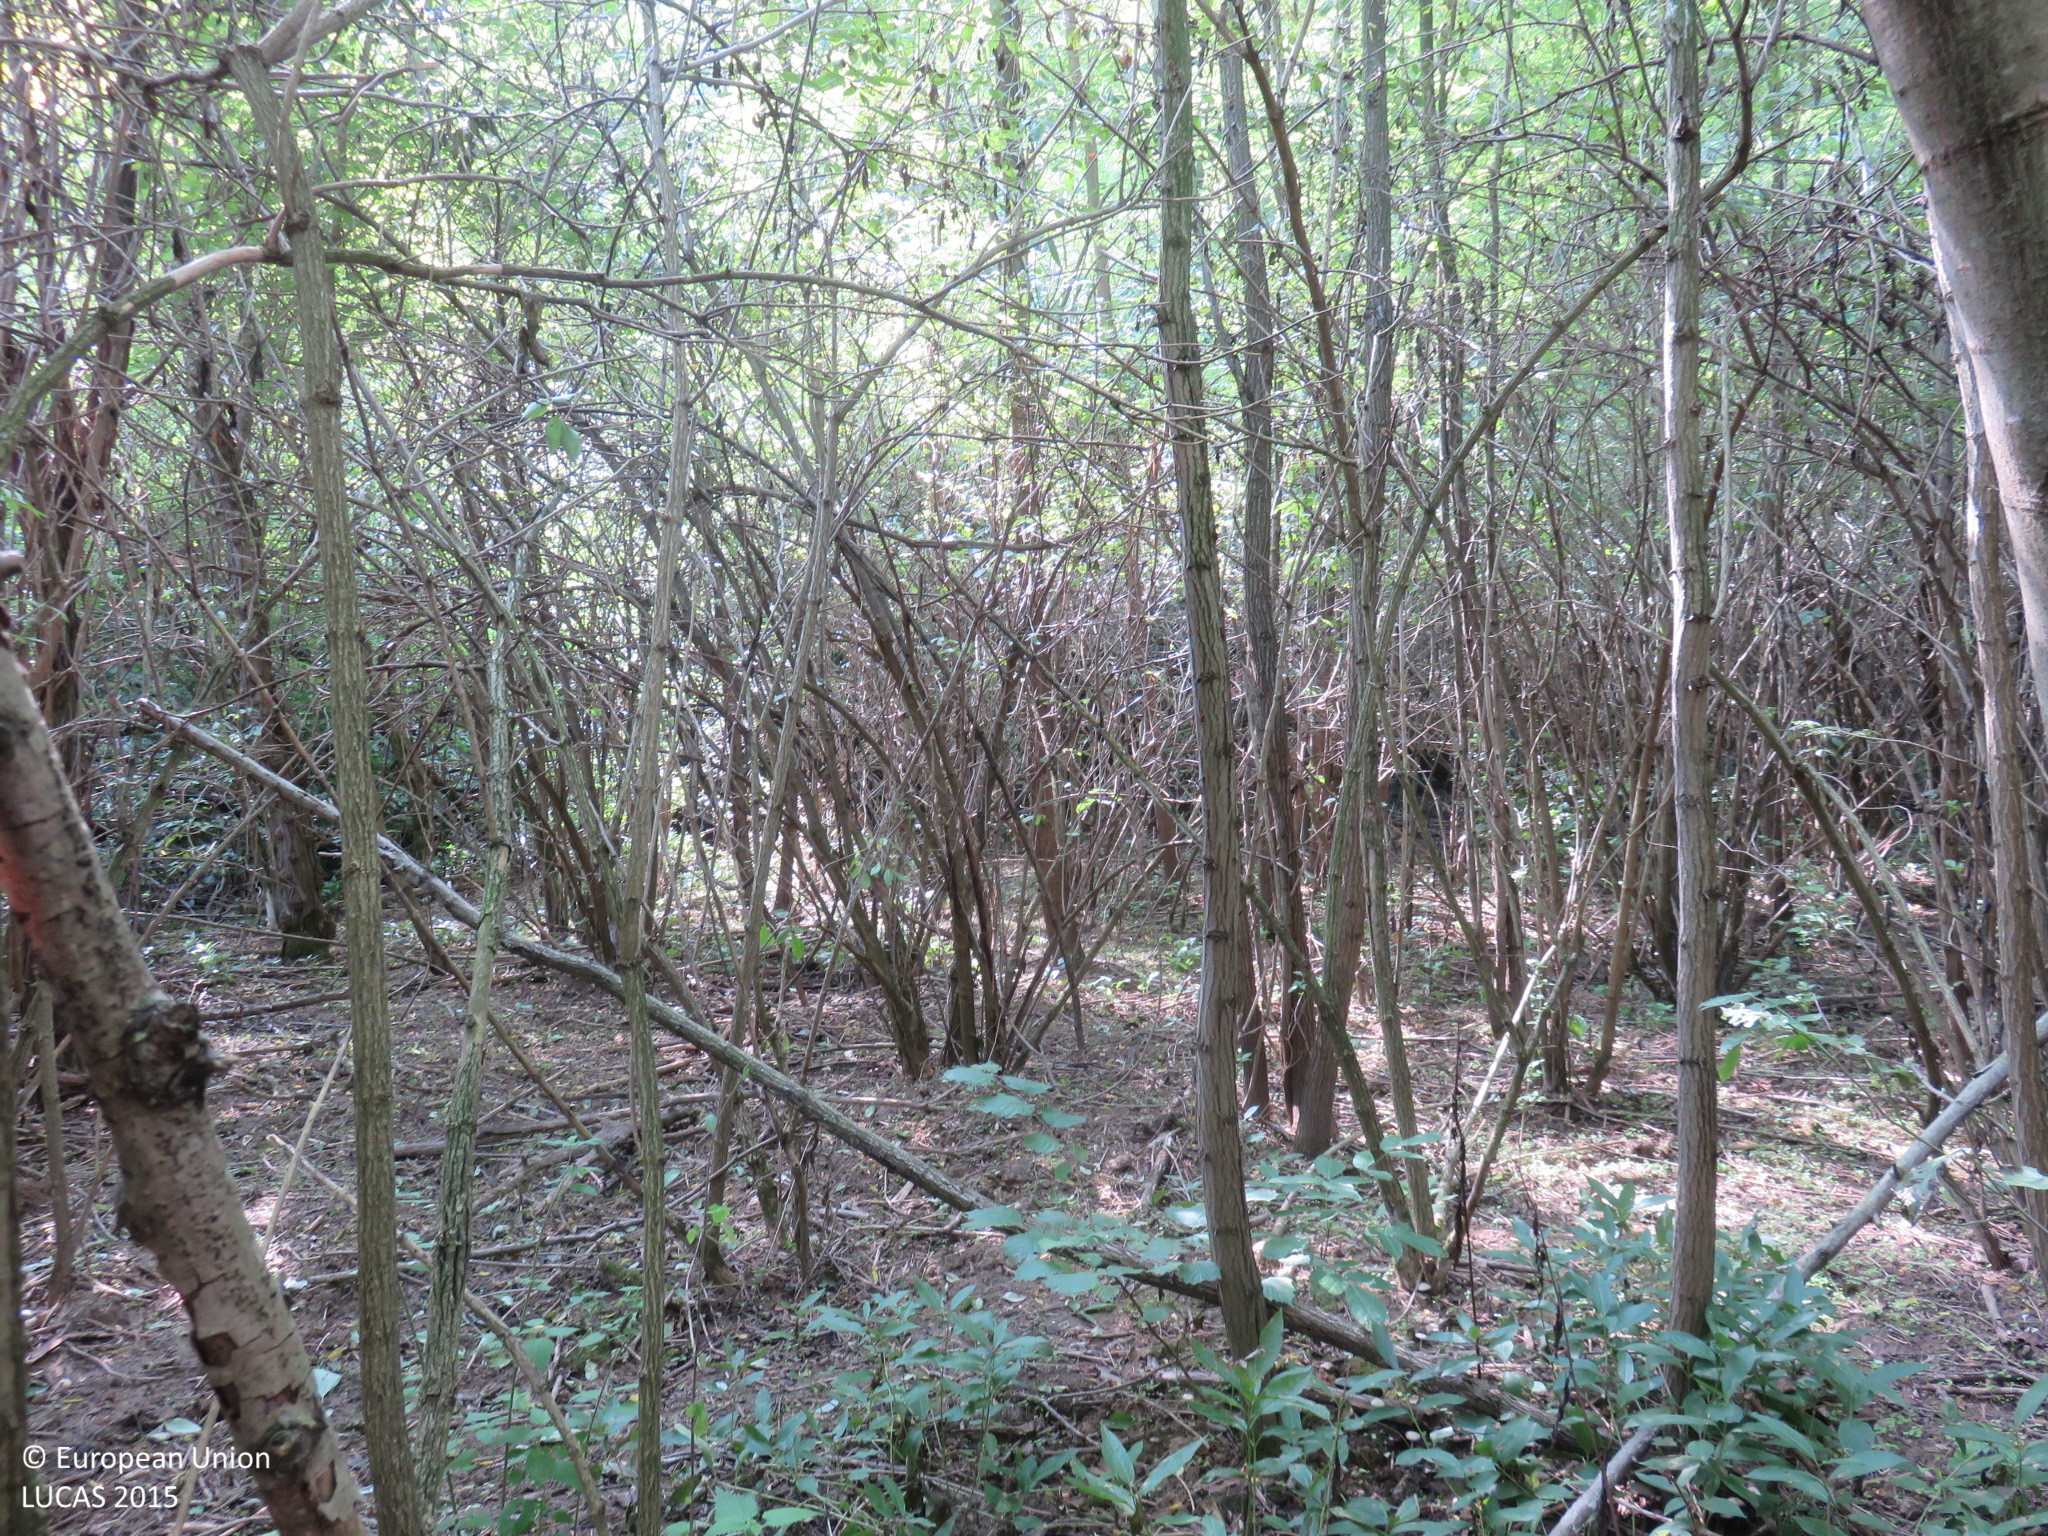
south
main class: Woodland
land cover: Broadleaved woodland
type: mesophytic deciduous forest
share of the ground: > 75 %
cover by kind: broadleaved forest trees 80 %, shrubs 20 %
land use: Semi-natural and natural areas not in use
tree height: < 5 m
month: September
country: BG
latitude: 43.6399
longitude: 24.9849
